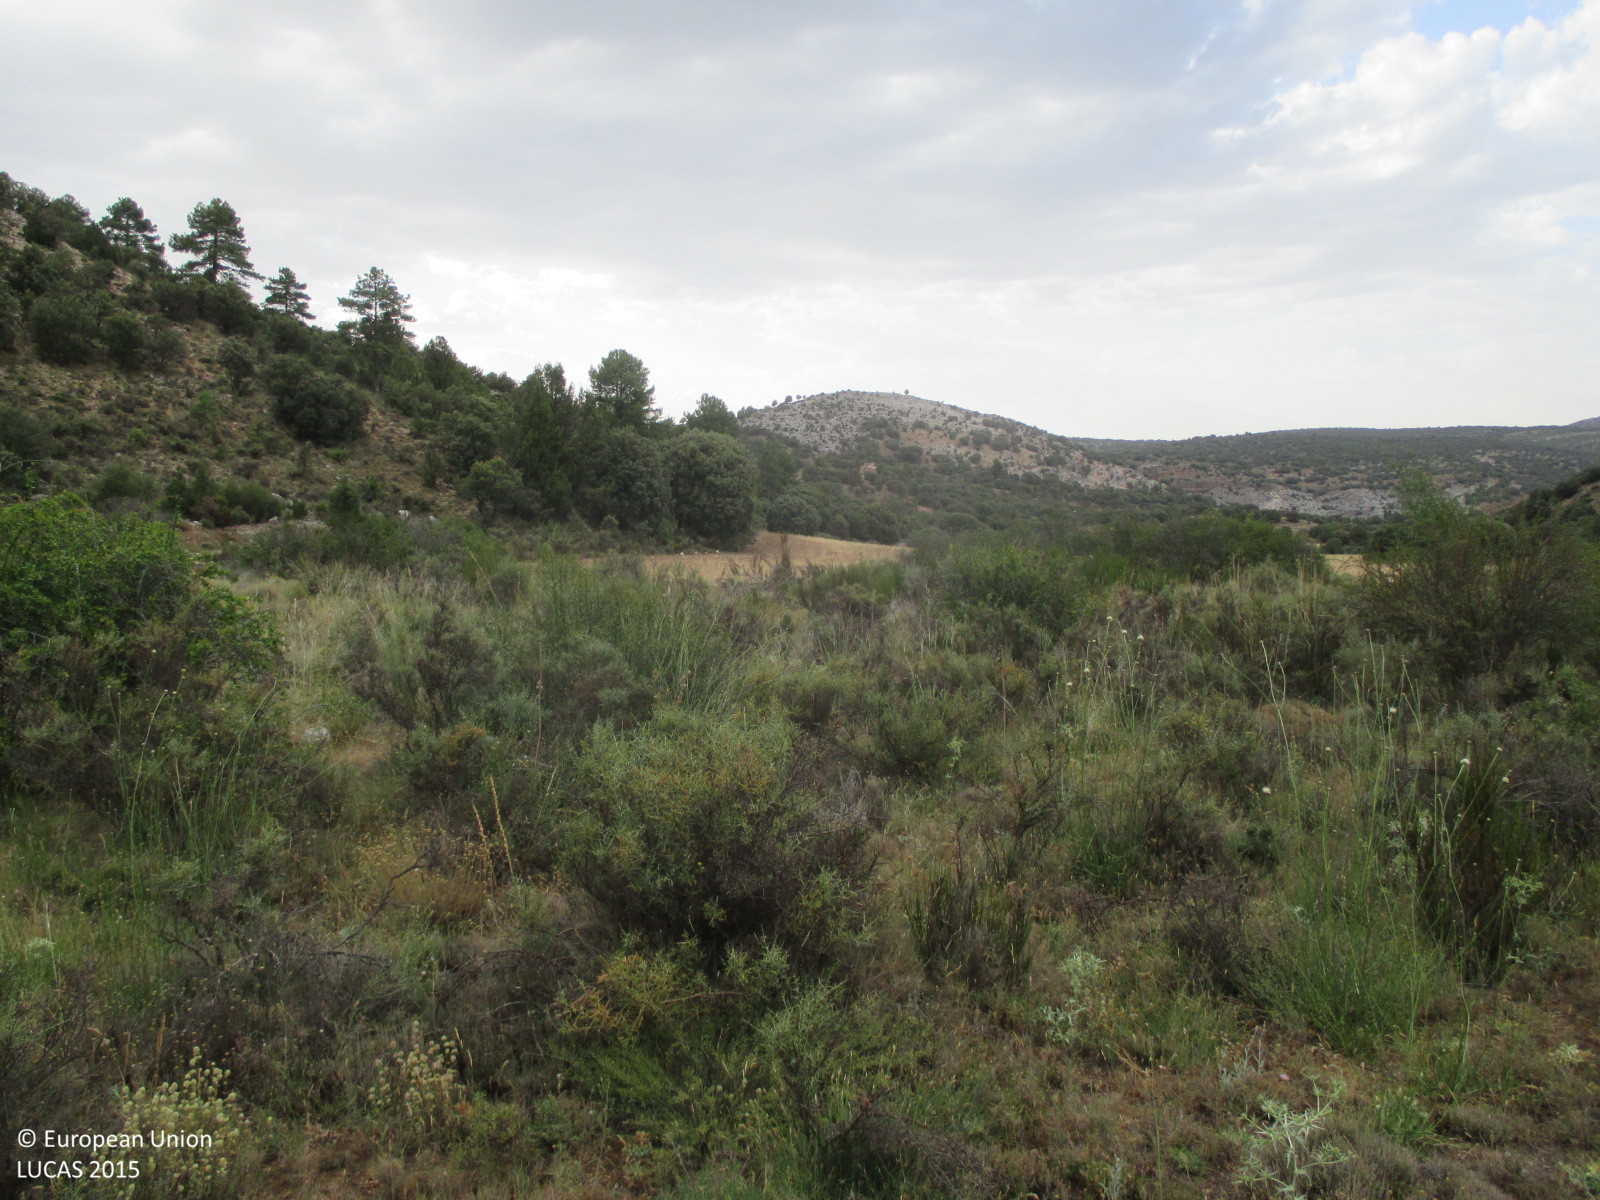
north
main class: Shrubland
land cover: Shrubland without tree cover
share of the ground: 50 - 75 %
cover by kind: shrubs 50 %, herbaceous plants 50 %
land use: Semi-natural and natural areas not in use
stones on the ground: < 10 %
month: July
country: ES
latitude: 38.1243
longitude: -2.3929
